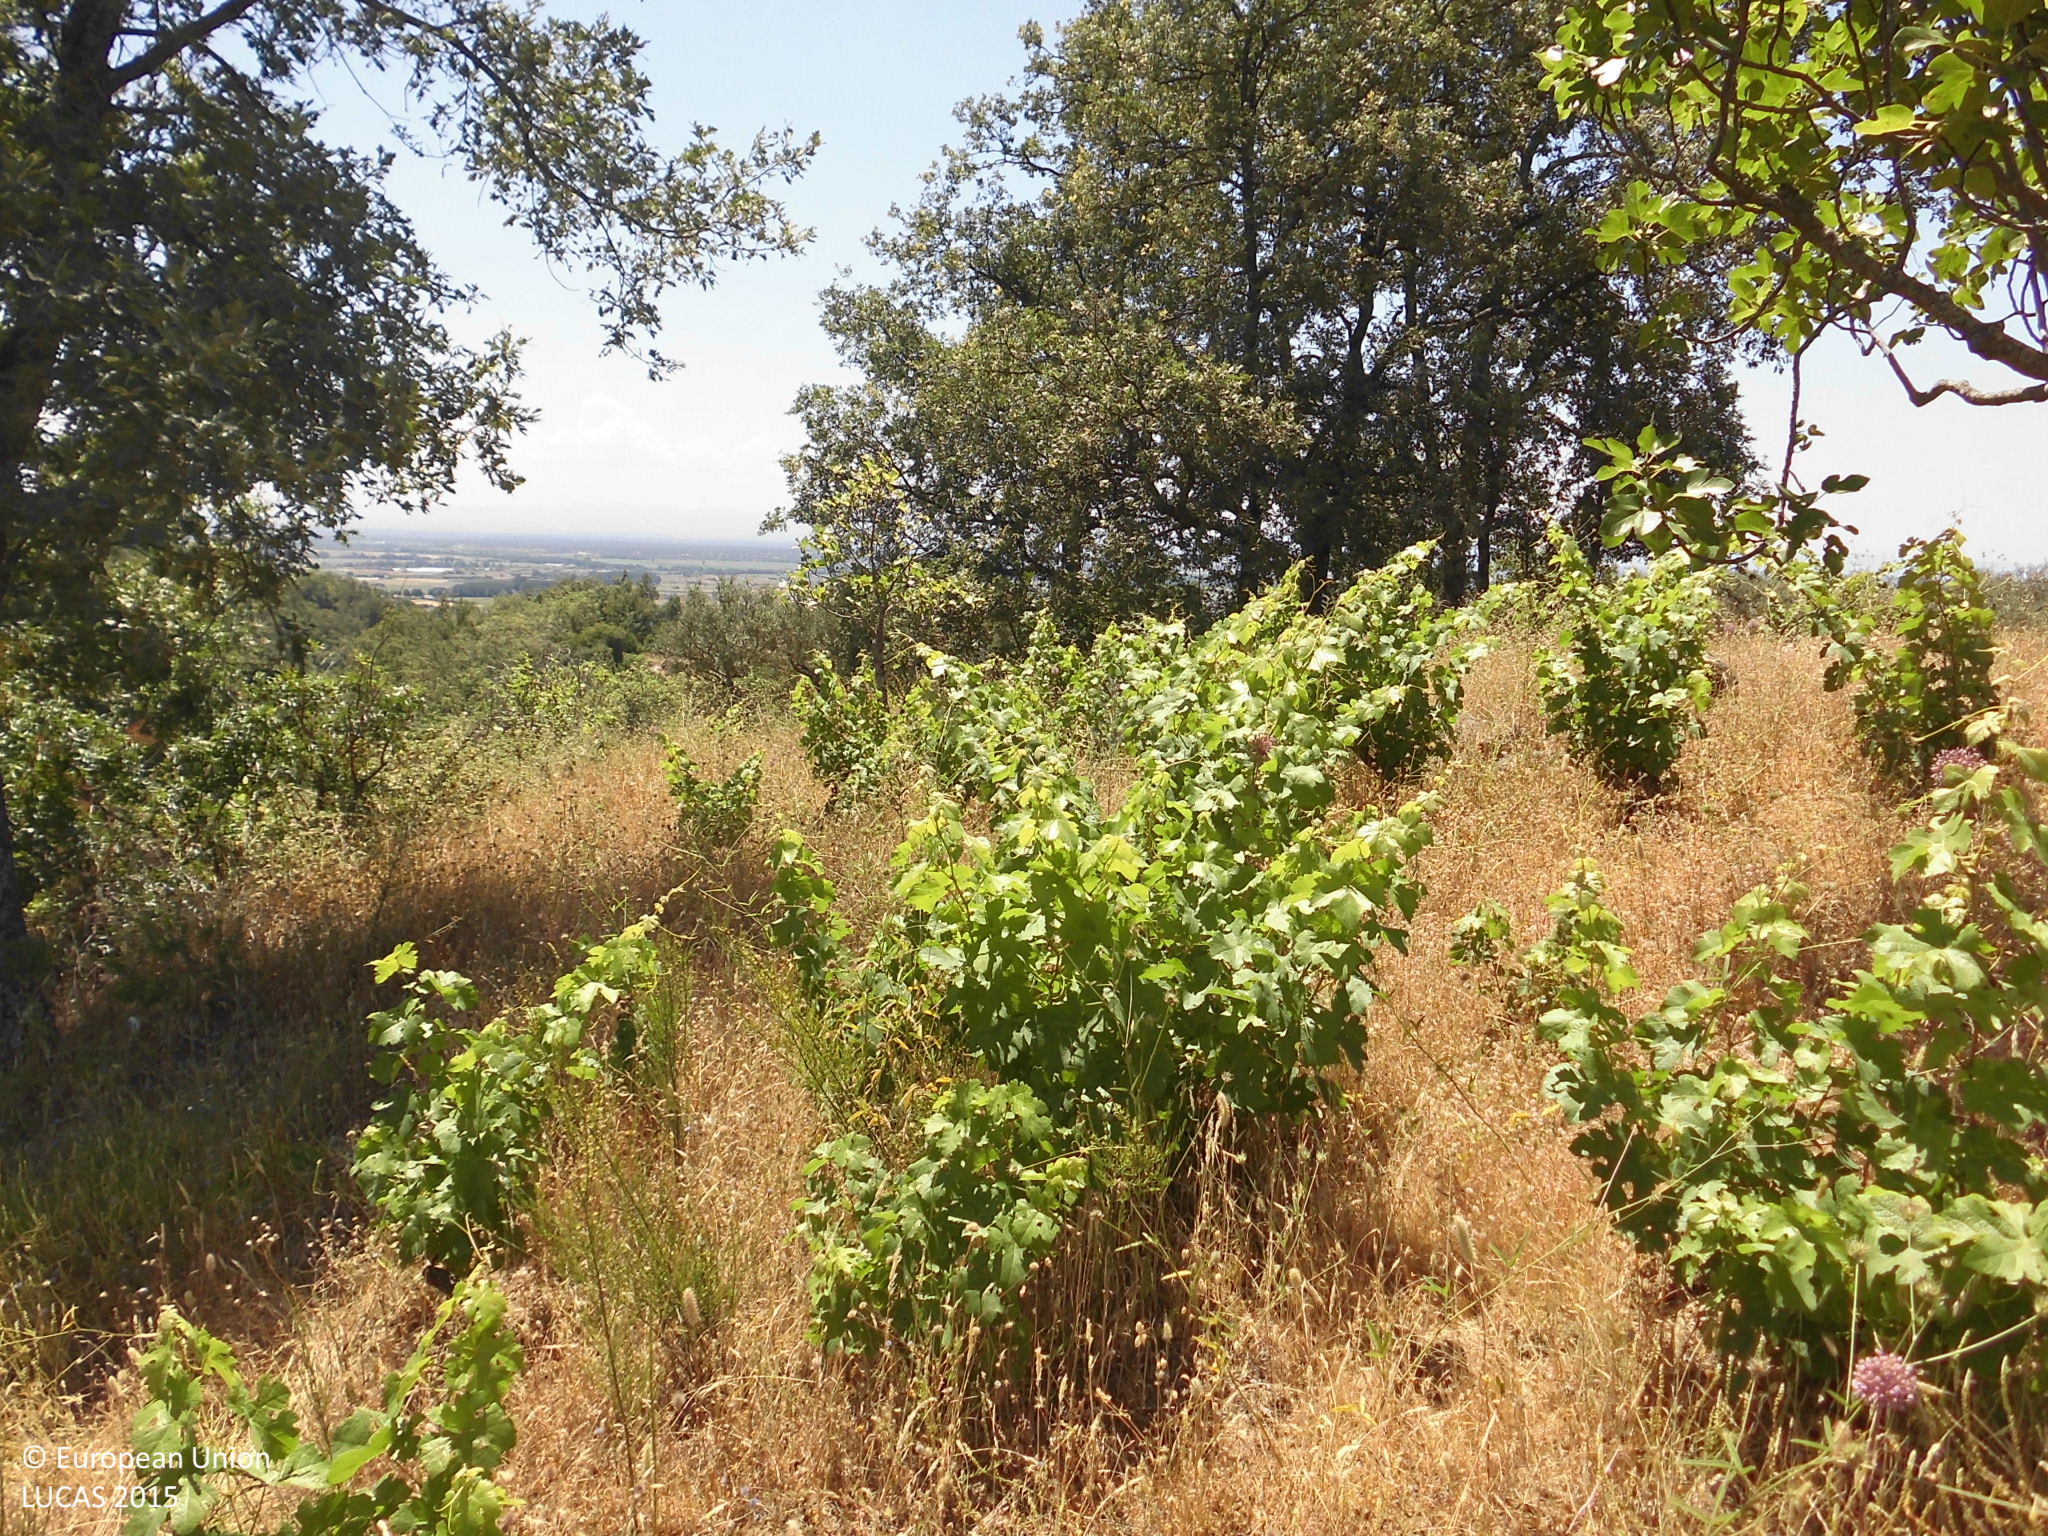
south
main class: Woodland
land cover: Broadleaved woodland
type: broadleaved evergreen forest
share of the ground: 25 - 50 %
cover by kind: herbaceous plants 55 %, broadleaved forest trees 35 %, shrubs 10 %
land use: Forestry
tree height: > 5 m
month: June
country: ES
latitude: 40.1059
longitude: -5.5358
